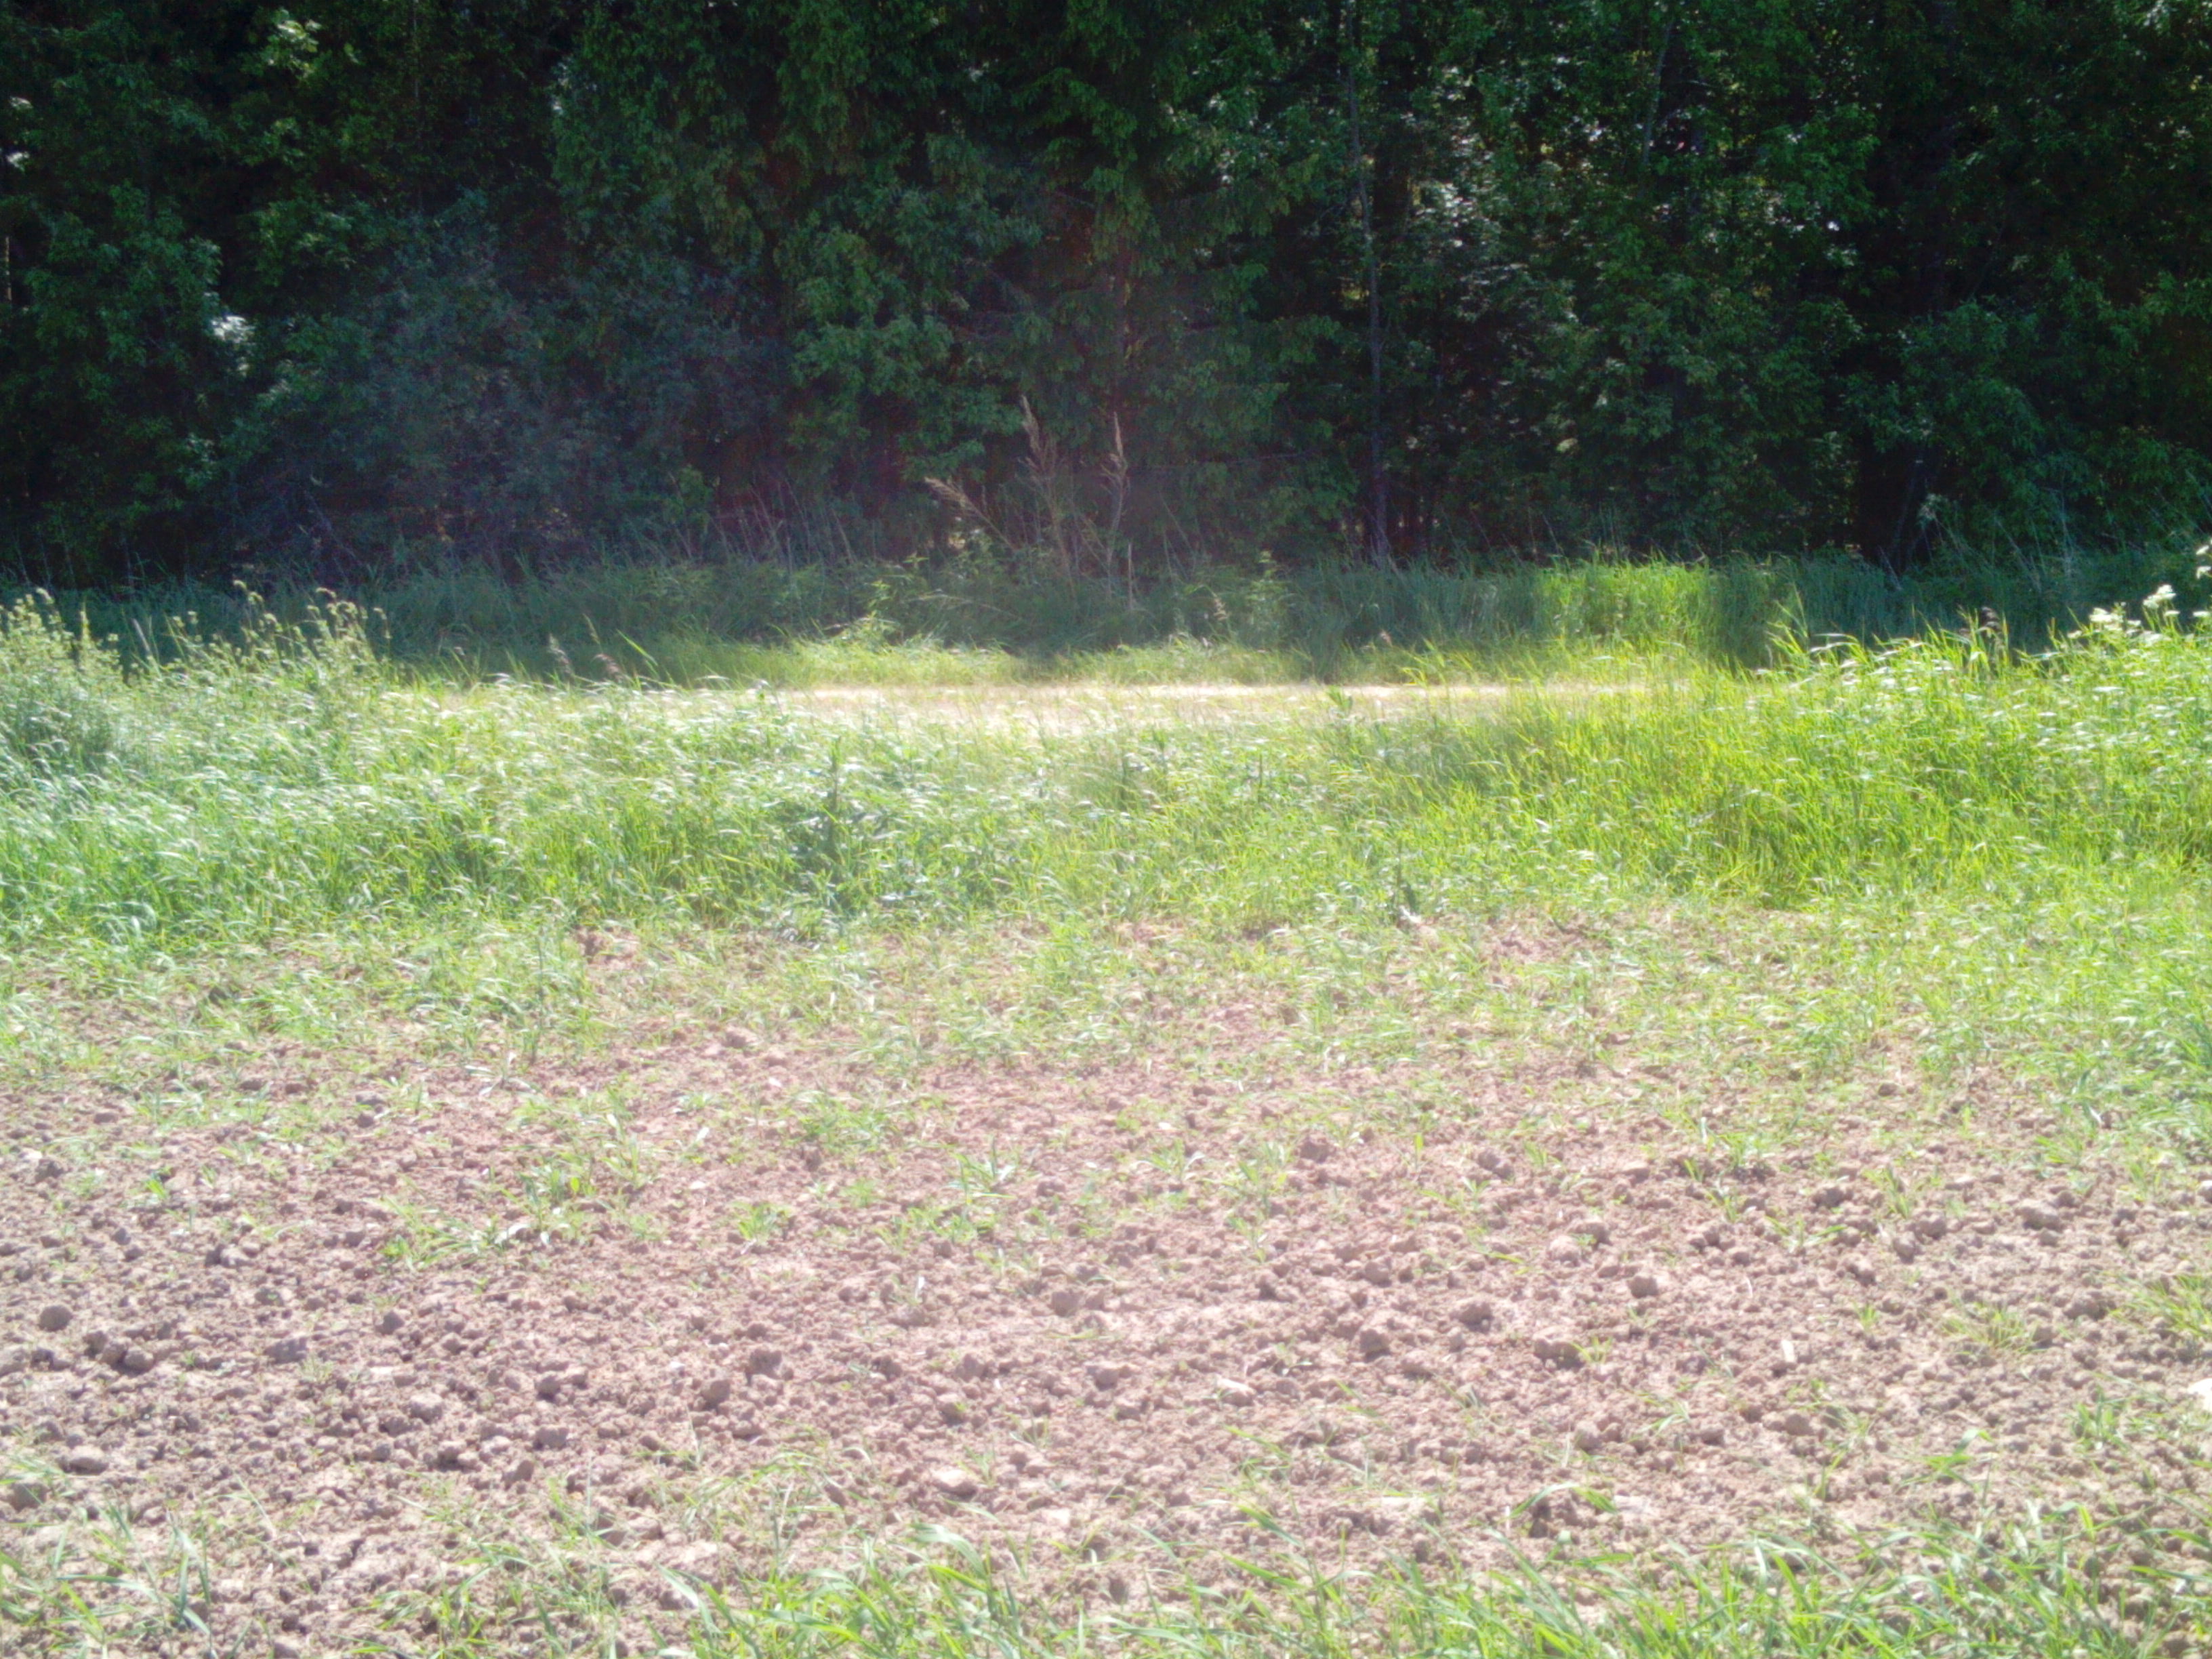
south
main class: Grassland
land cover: Spontaneously vegetated surfaces
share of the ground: < 10 %
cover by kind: unconsolidated bare surface 90 %, herbaceous plants 10 %
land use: Fallow land
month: June
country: LV
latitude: 56.6556
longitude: 22.2376
